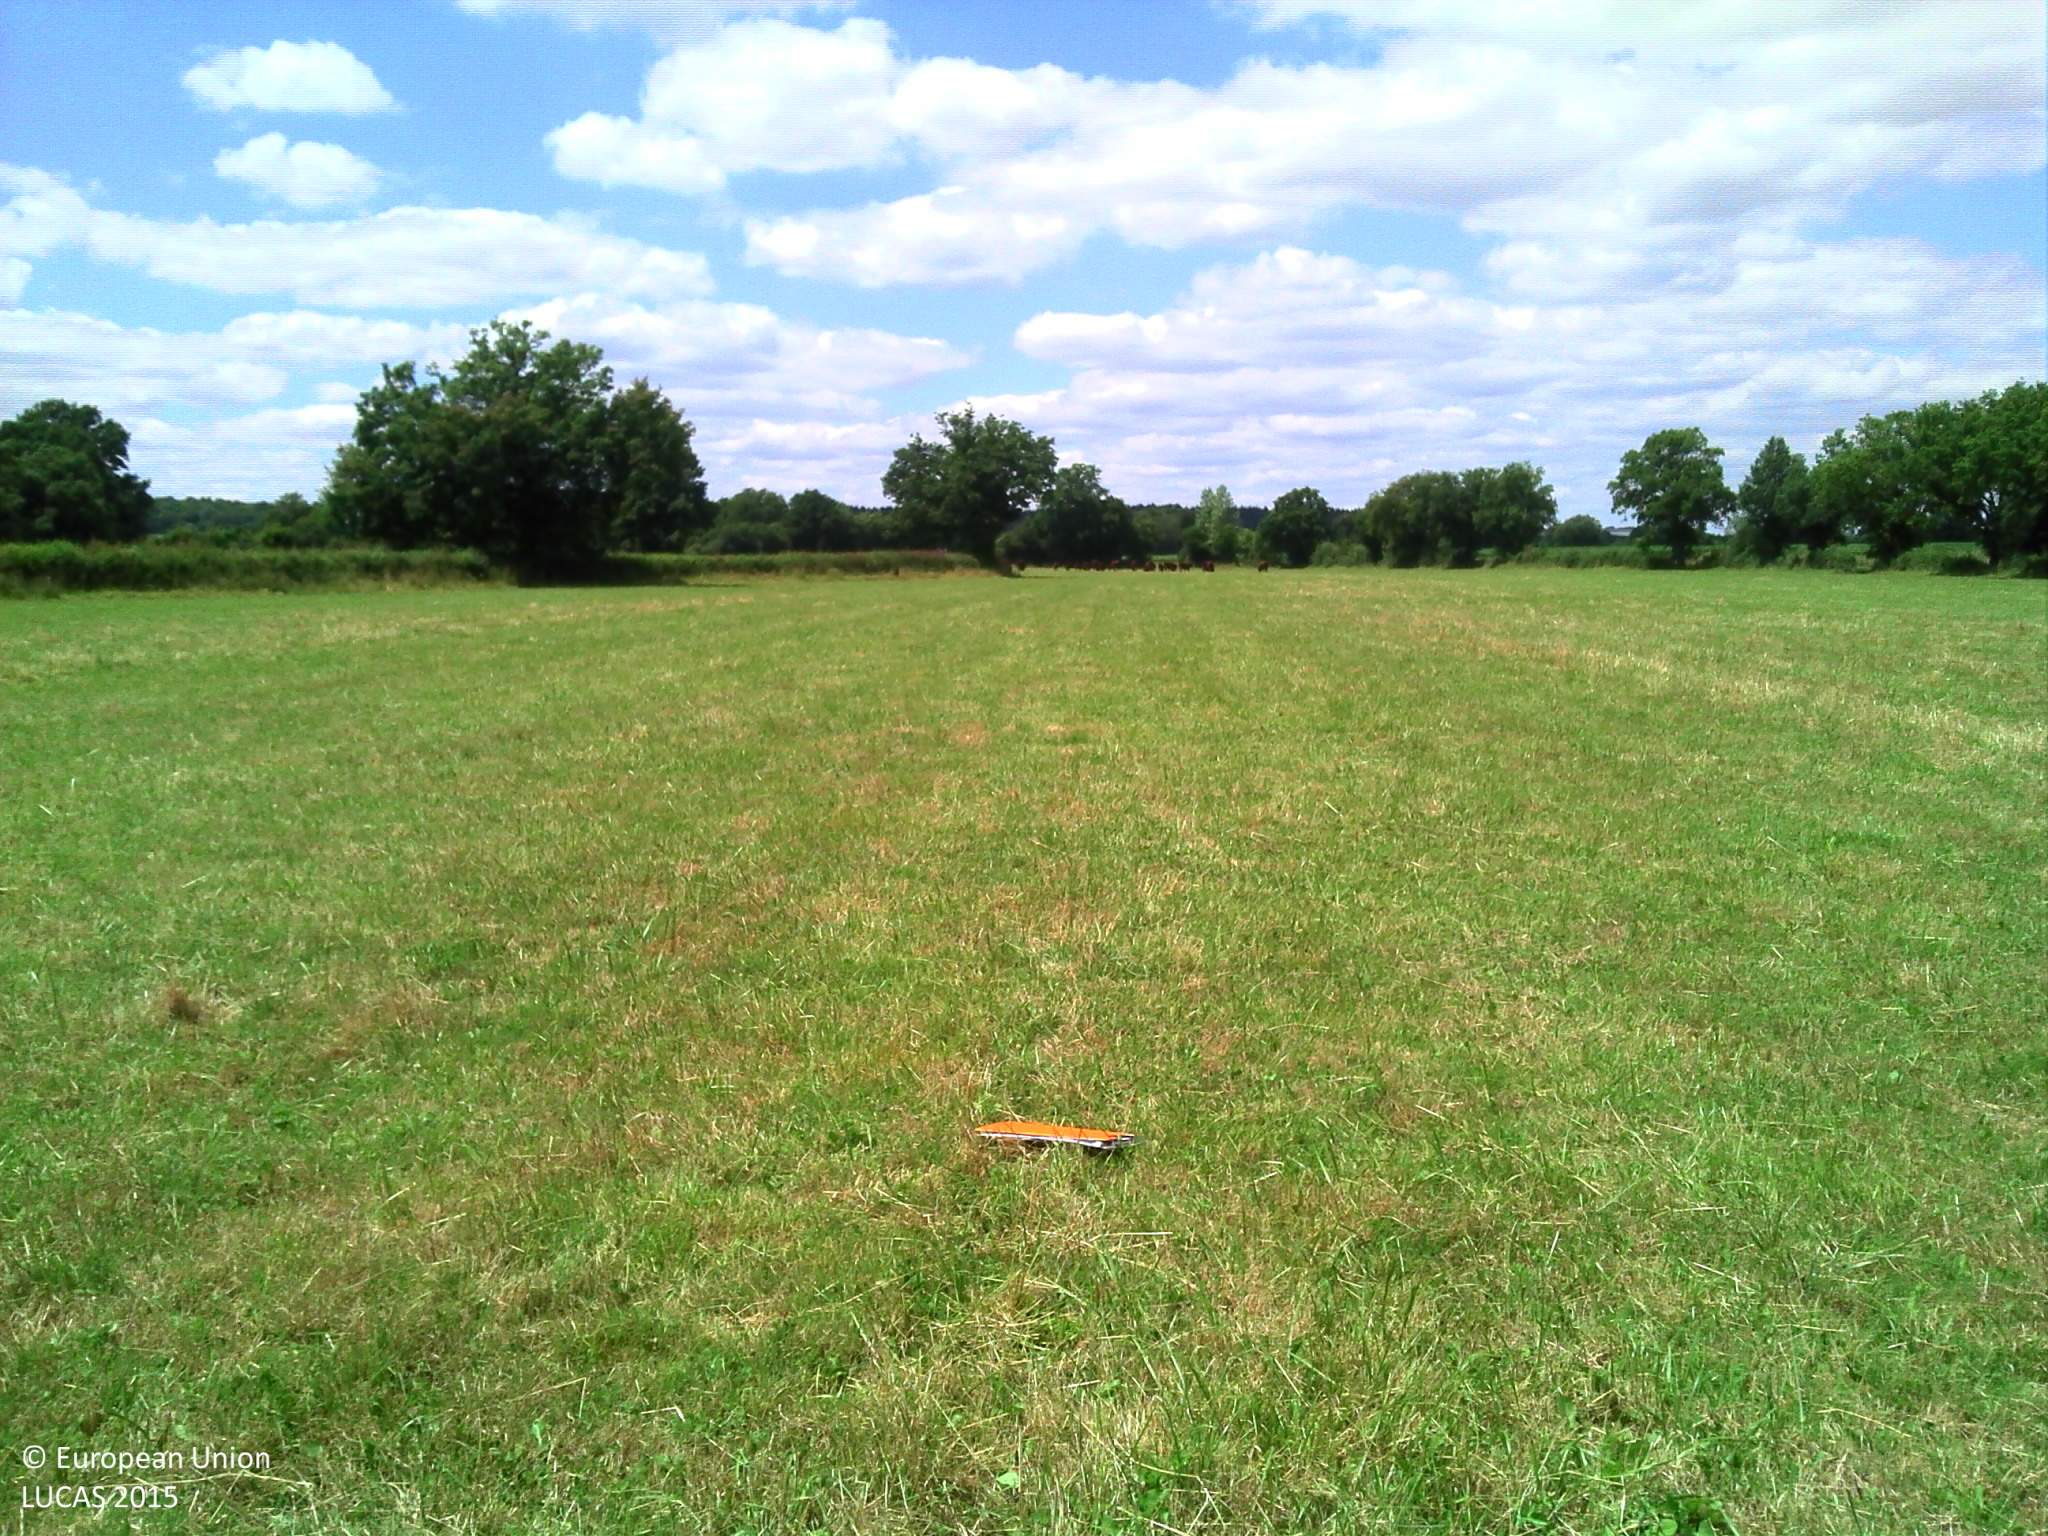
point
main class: Grassland
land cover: Grassland without tree/shrub cover
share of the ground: > 75 %
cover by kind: herbaceous plants 100 %
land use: Agriculture (excluding fallow land and kitchen gardens)
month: June
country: FR
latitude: 46.6509
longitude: 3.6617
